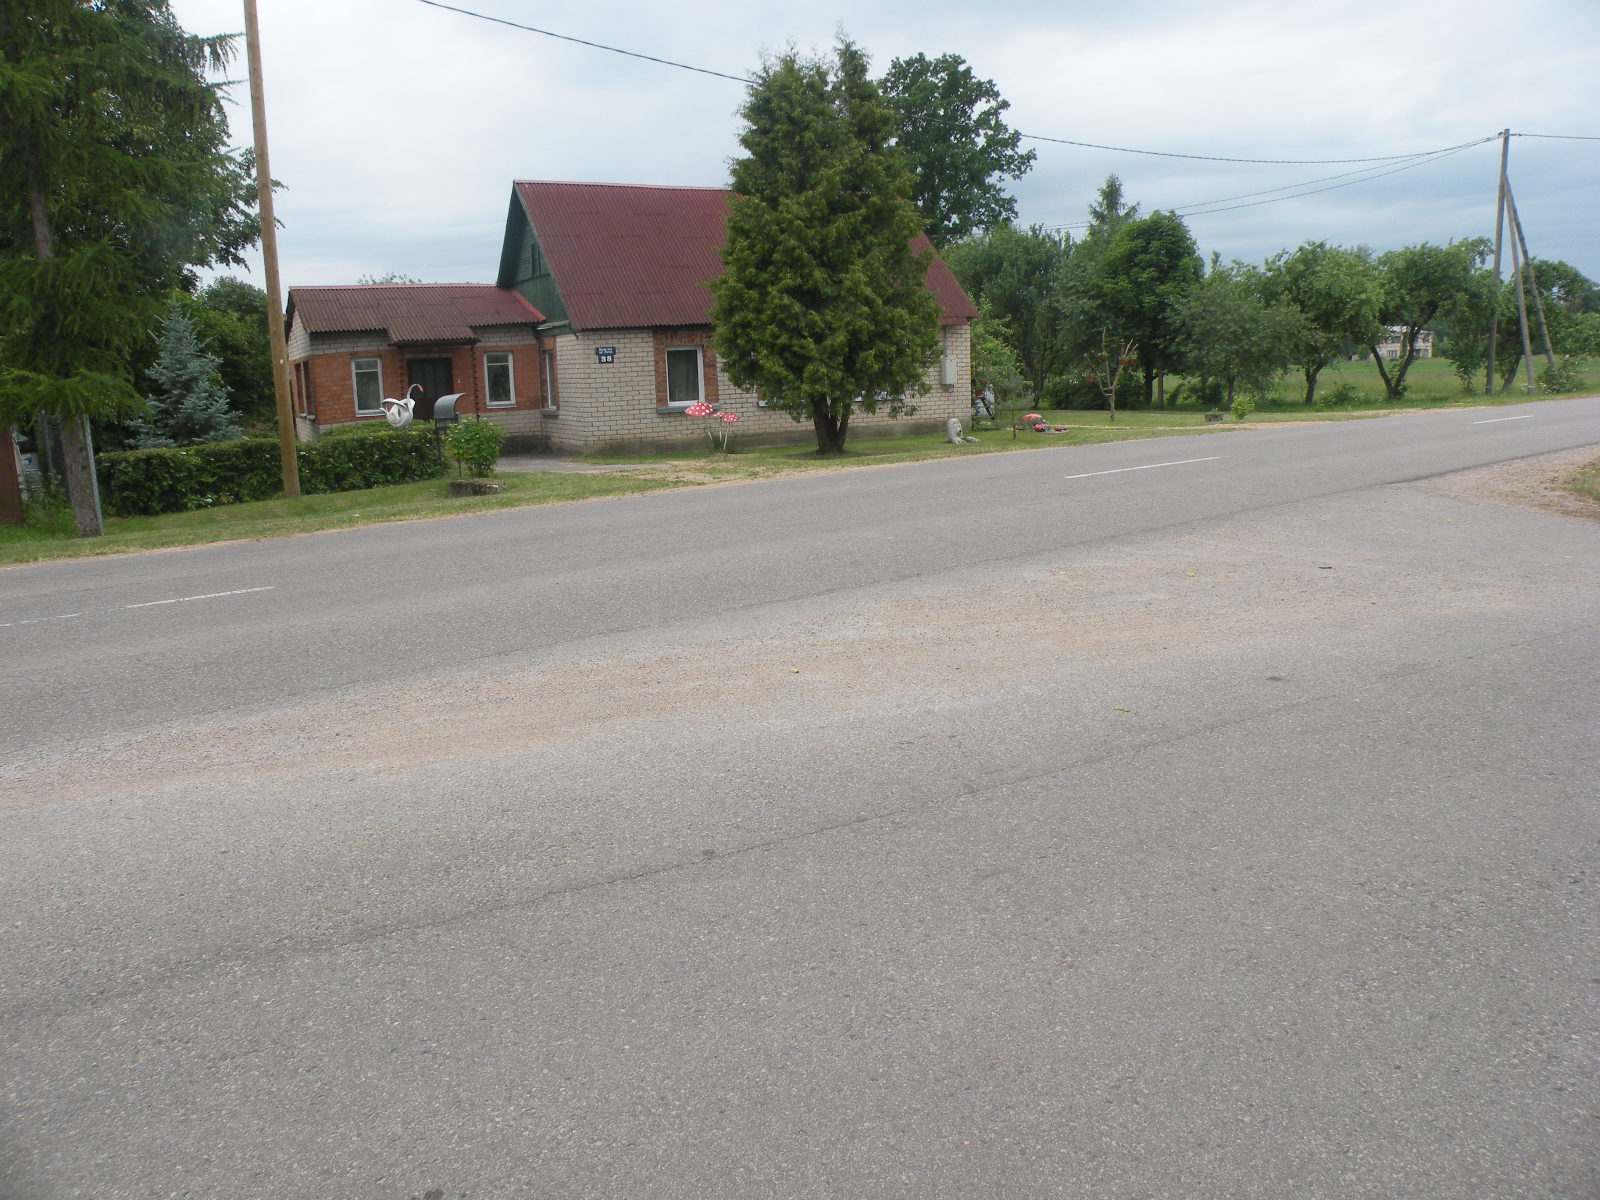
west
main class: Cropland
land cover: Other root crops
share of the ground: 50 - 75 %
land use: Kitchen garden
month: June
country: LV
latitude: 56.0773
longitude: 26.6882
